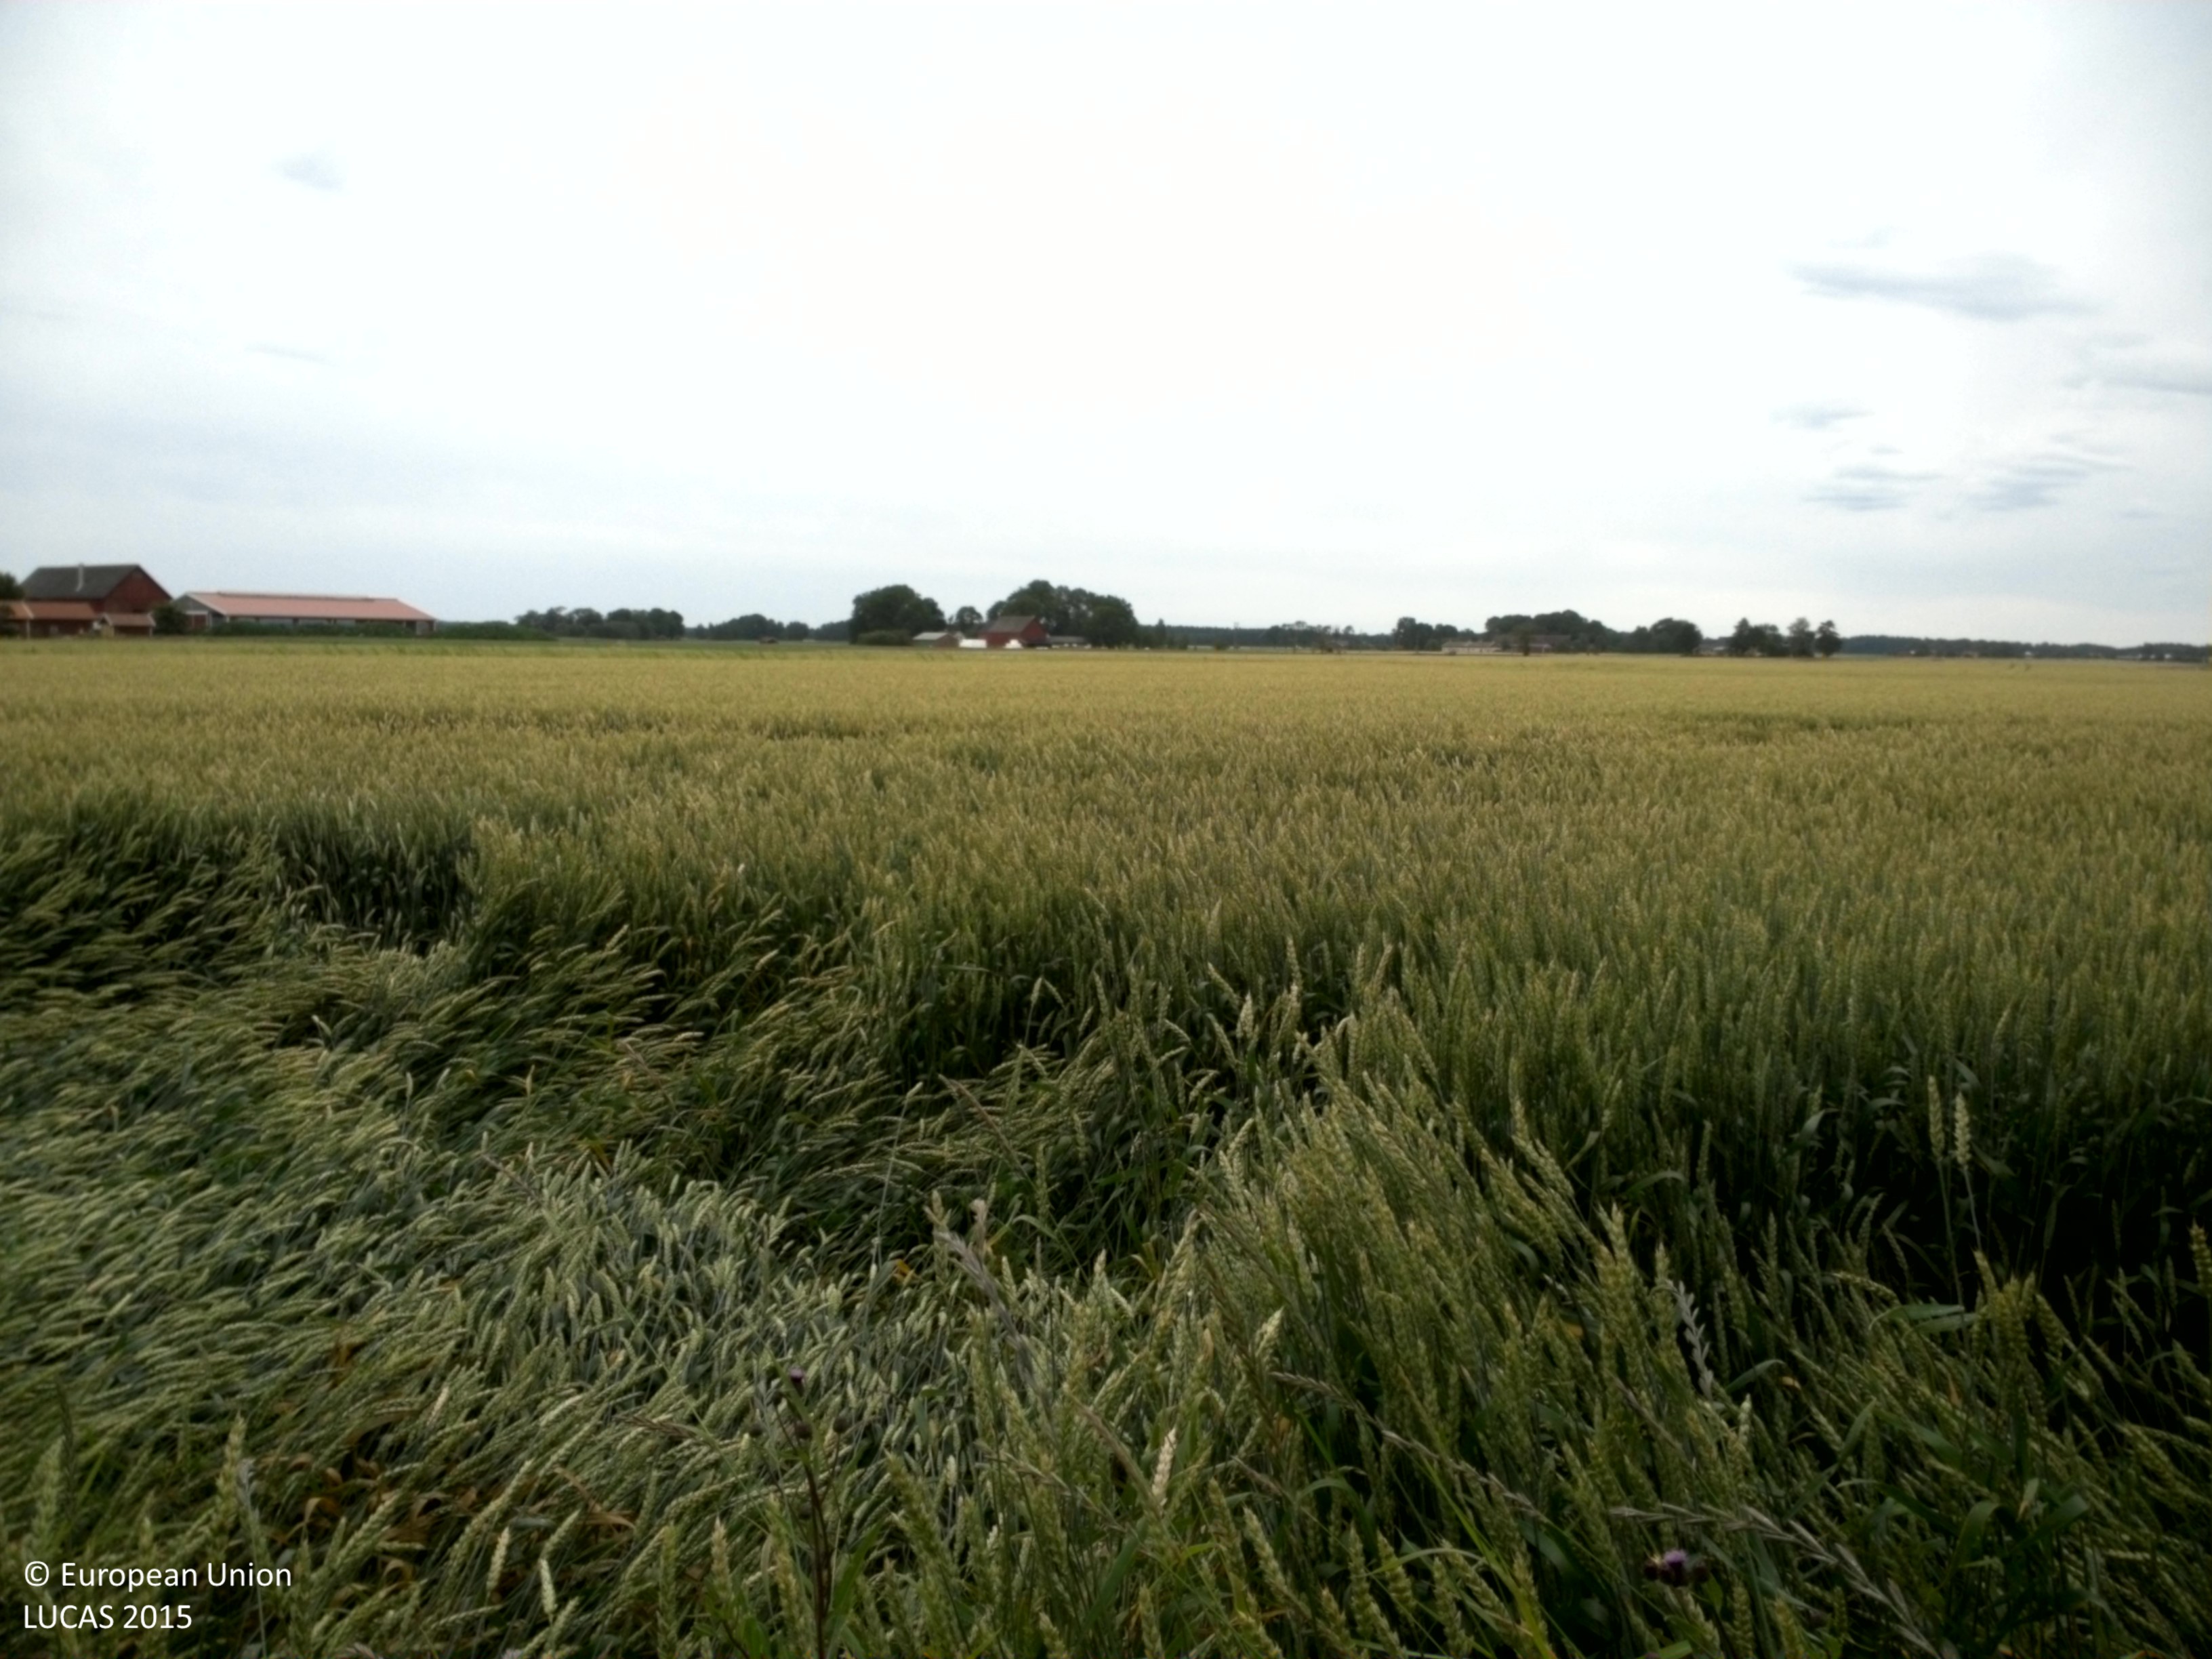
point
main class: Cropland
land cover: Common wheat
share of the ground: > 75 %
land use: Agriculture (excluding fallow land and kitchen gardens)
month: July
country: SE
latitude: 58.3780
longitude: 13.2604
